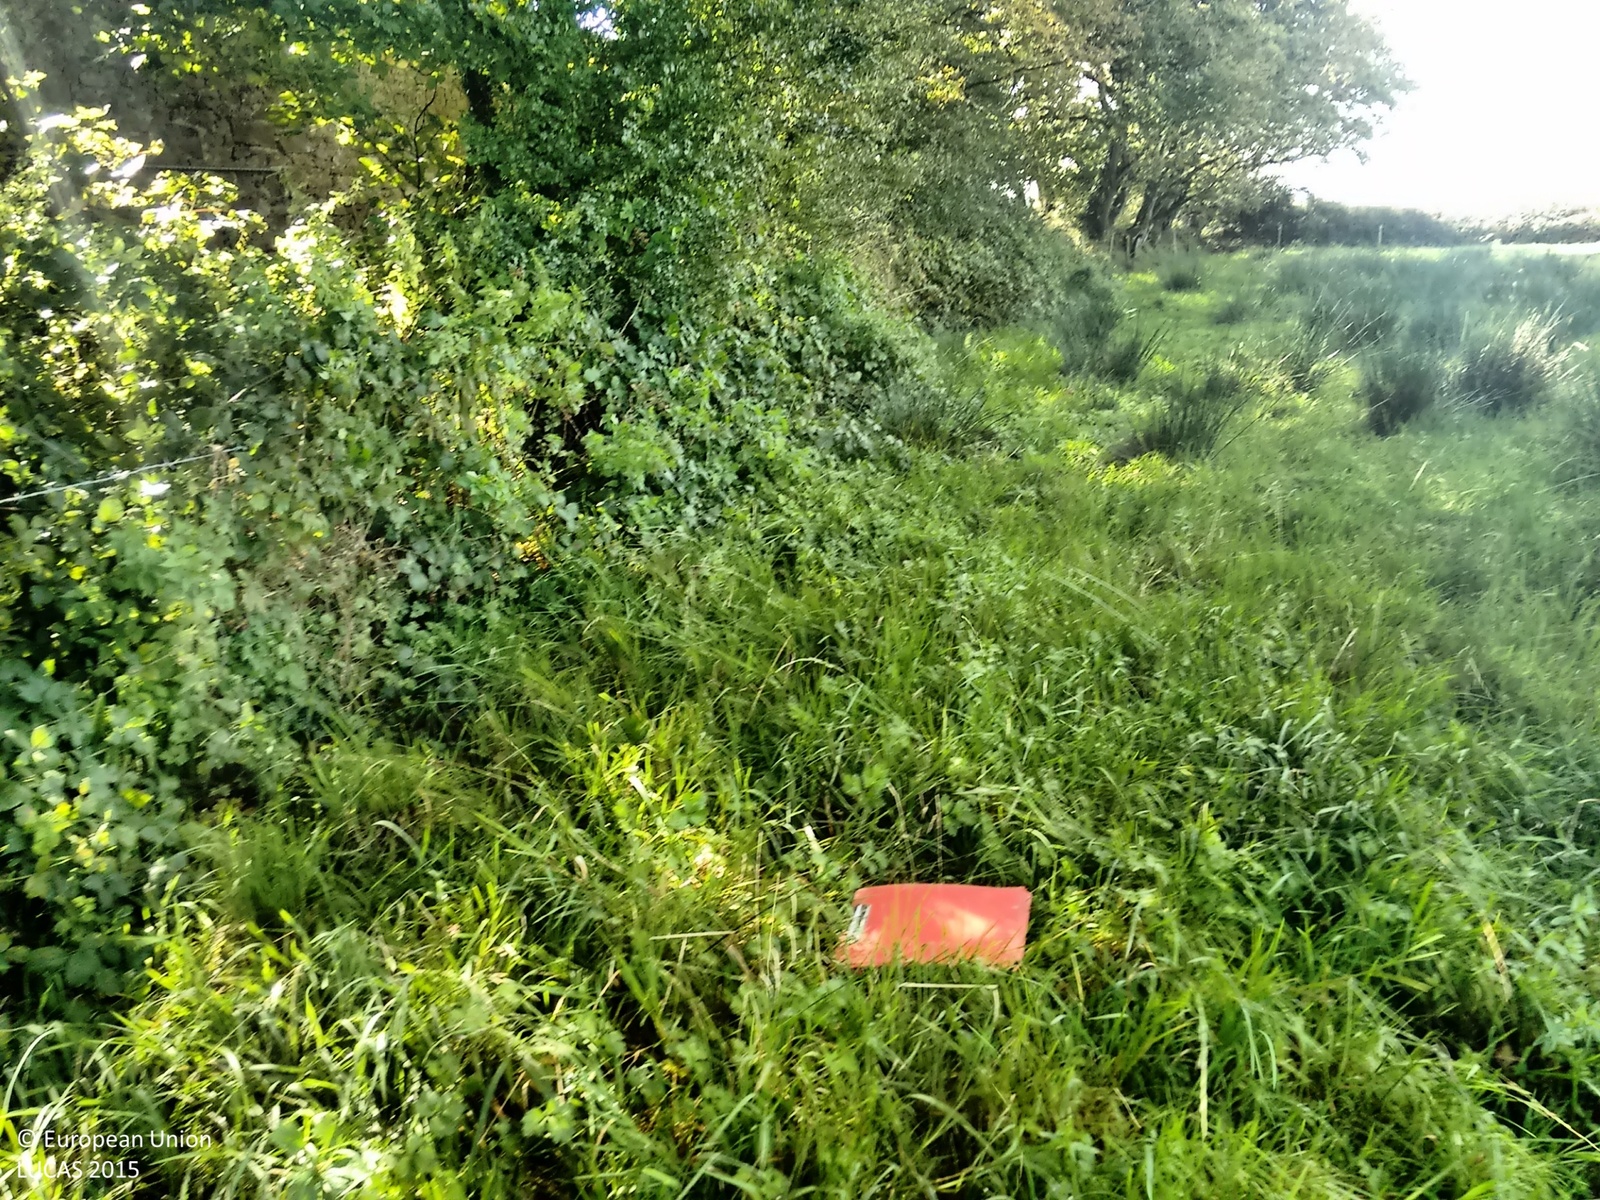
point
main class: Grassland
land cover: Grassland without tree/shrub cover
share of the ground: > 75 %
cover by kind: herbaceous plants 100 %
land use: Agriculture (excluding fallow land and kitchen gardens)
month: September
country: GB
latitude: 50.7682
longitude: -4.2064
